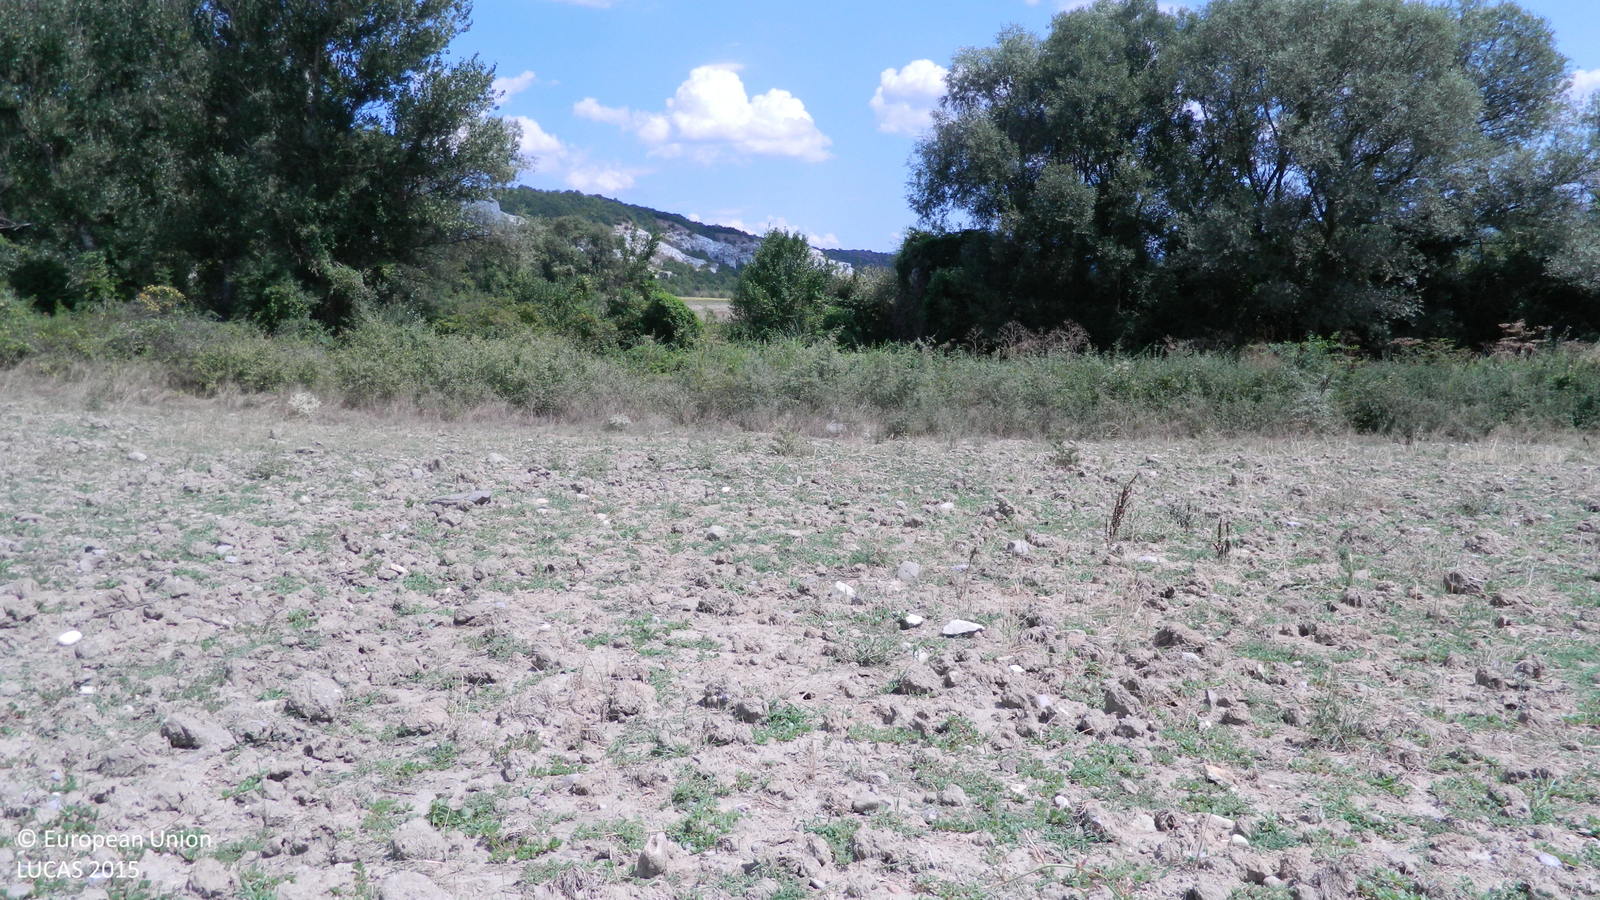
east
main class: Cropland
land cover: Other cereals
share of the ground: < 10 %
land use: Agriculture (excluding fallow land and kitchen gardens)
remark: Harvested field
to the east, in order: Other cereals; Shrubland with sparse tree cover; Spontaneously vegetated surfaces; Broadleaved woodland; Rivers and streams; Broadleaved woodland; Shrubland with sparse tree cover; Grass margins; Tracks; Common wheat; Spontaneously vegetated surfaces
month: August
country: BG
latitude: 41.6262
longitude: 25.6784
